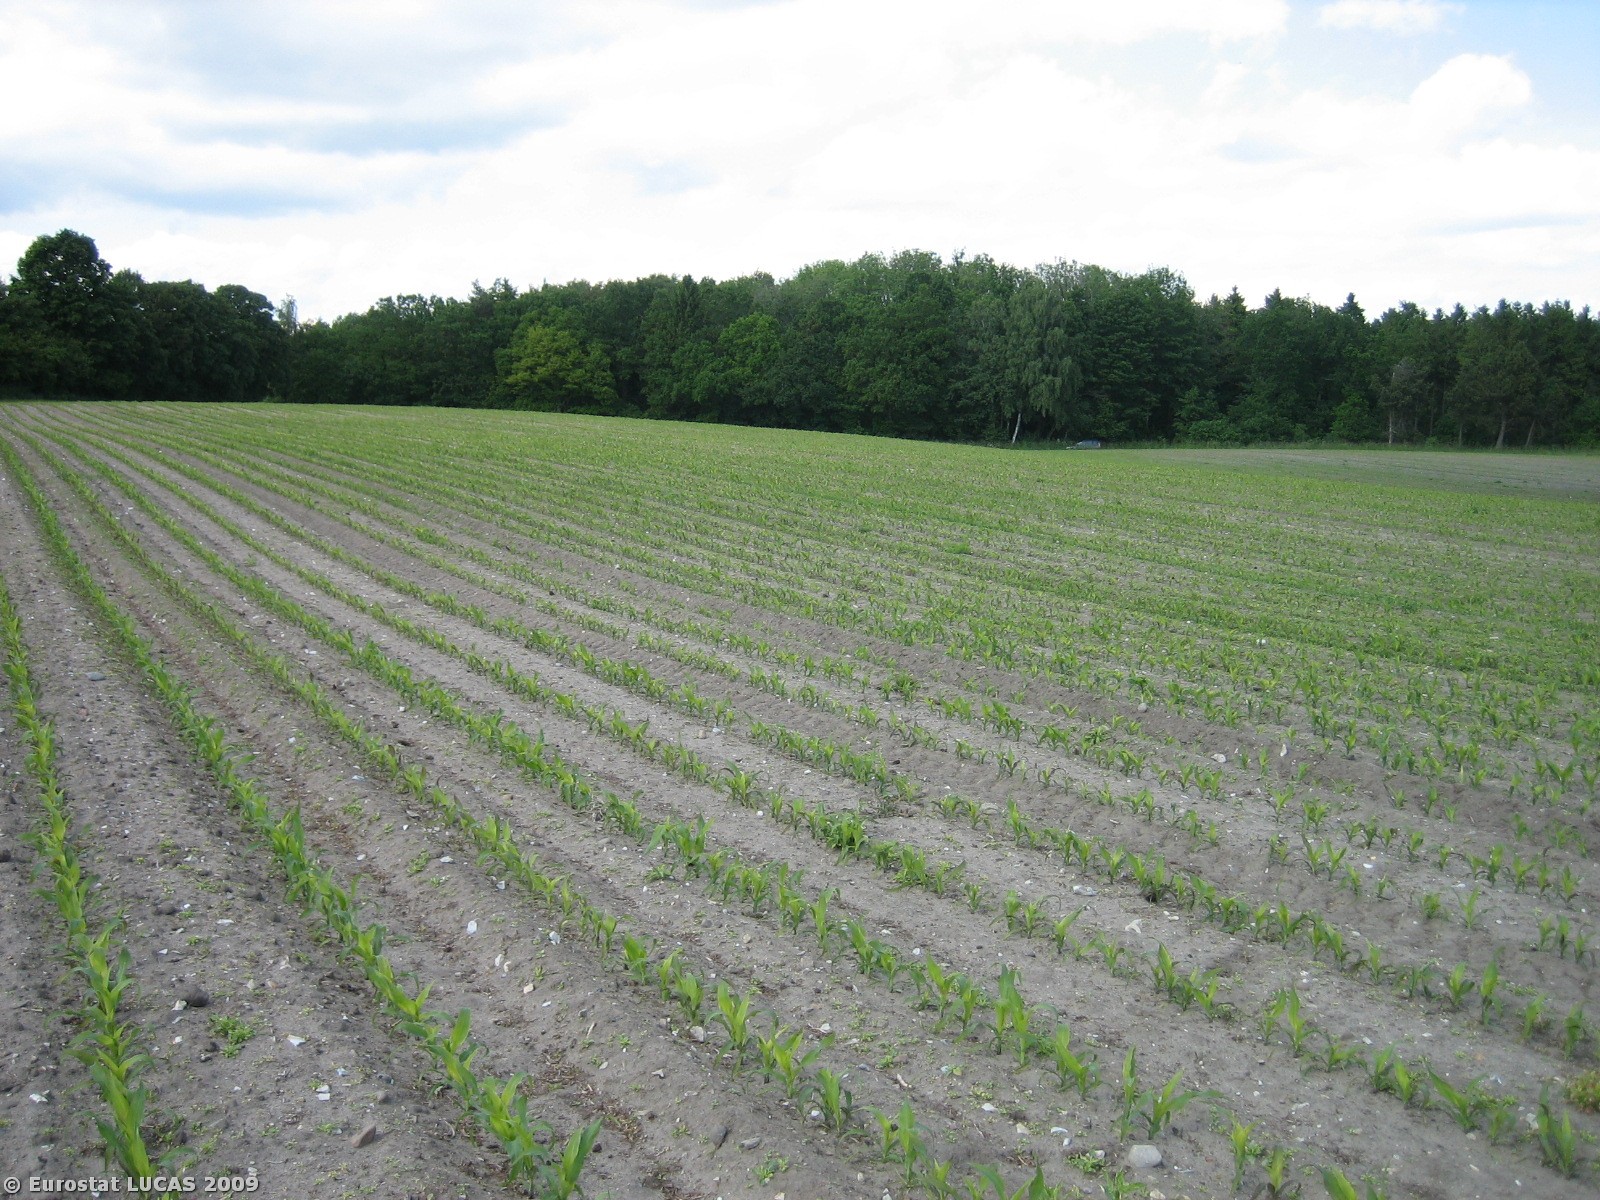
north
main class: Cropland
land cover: Maize
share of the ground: < 10 %
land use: Agriculture (excluding fallow land and kitchen gardens)
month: June
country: DK
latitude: 56.0079
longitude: 9.8558
